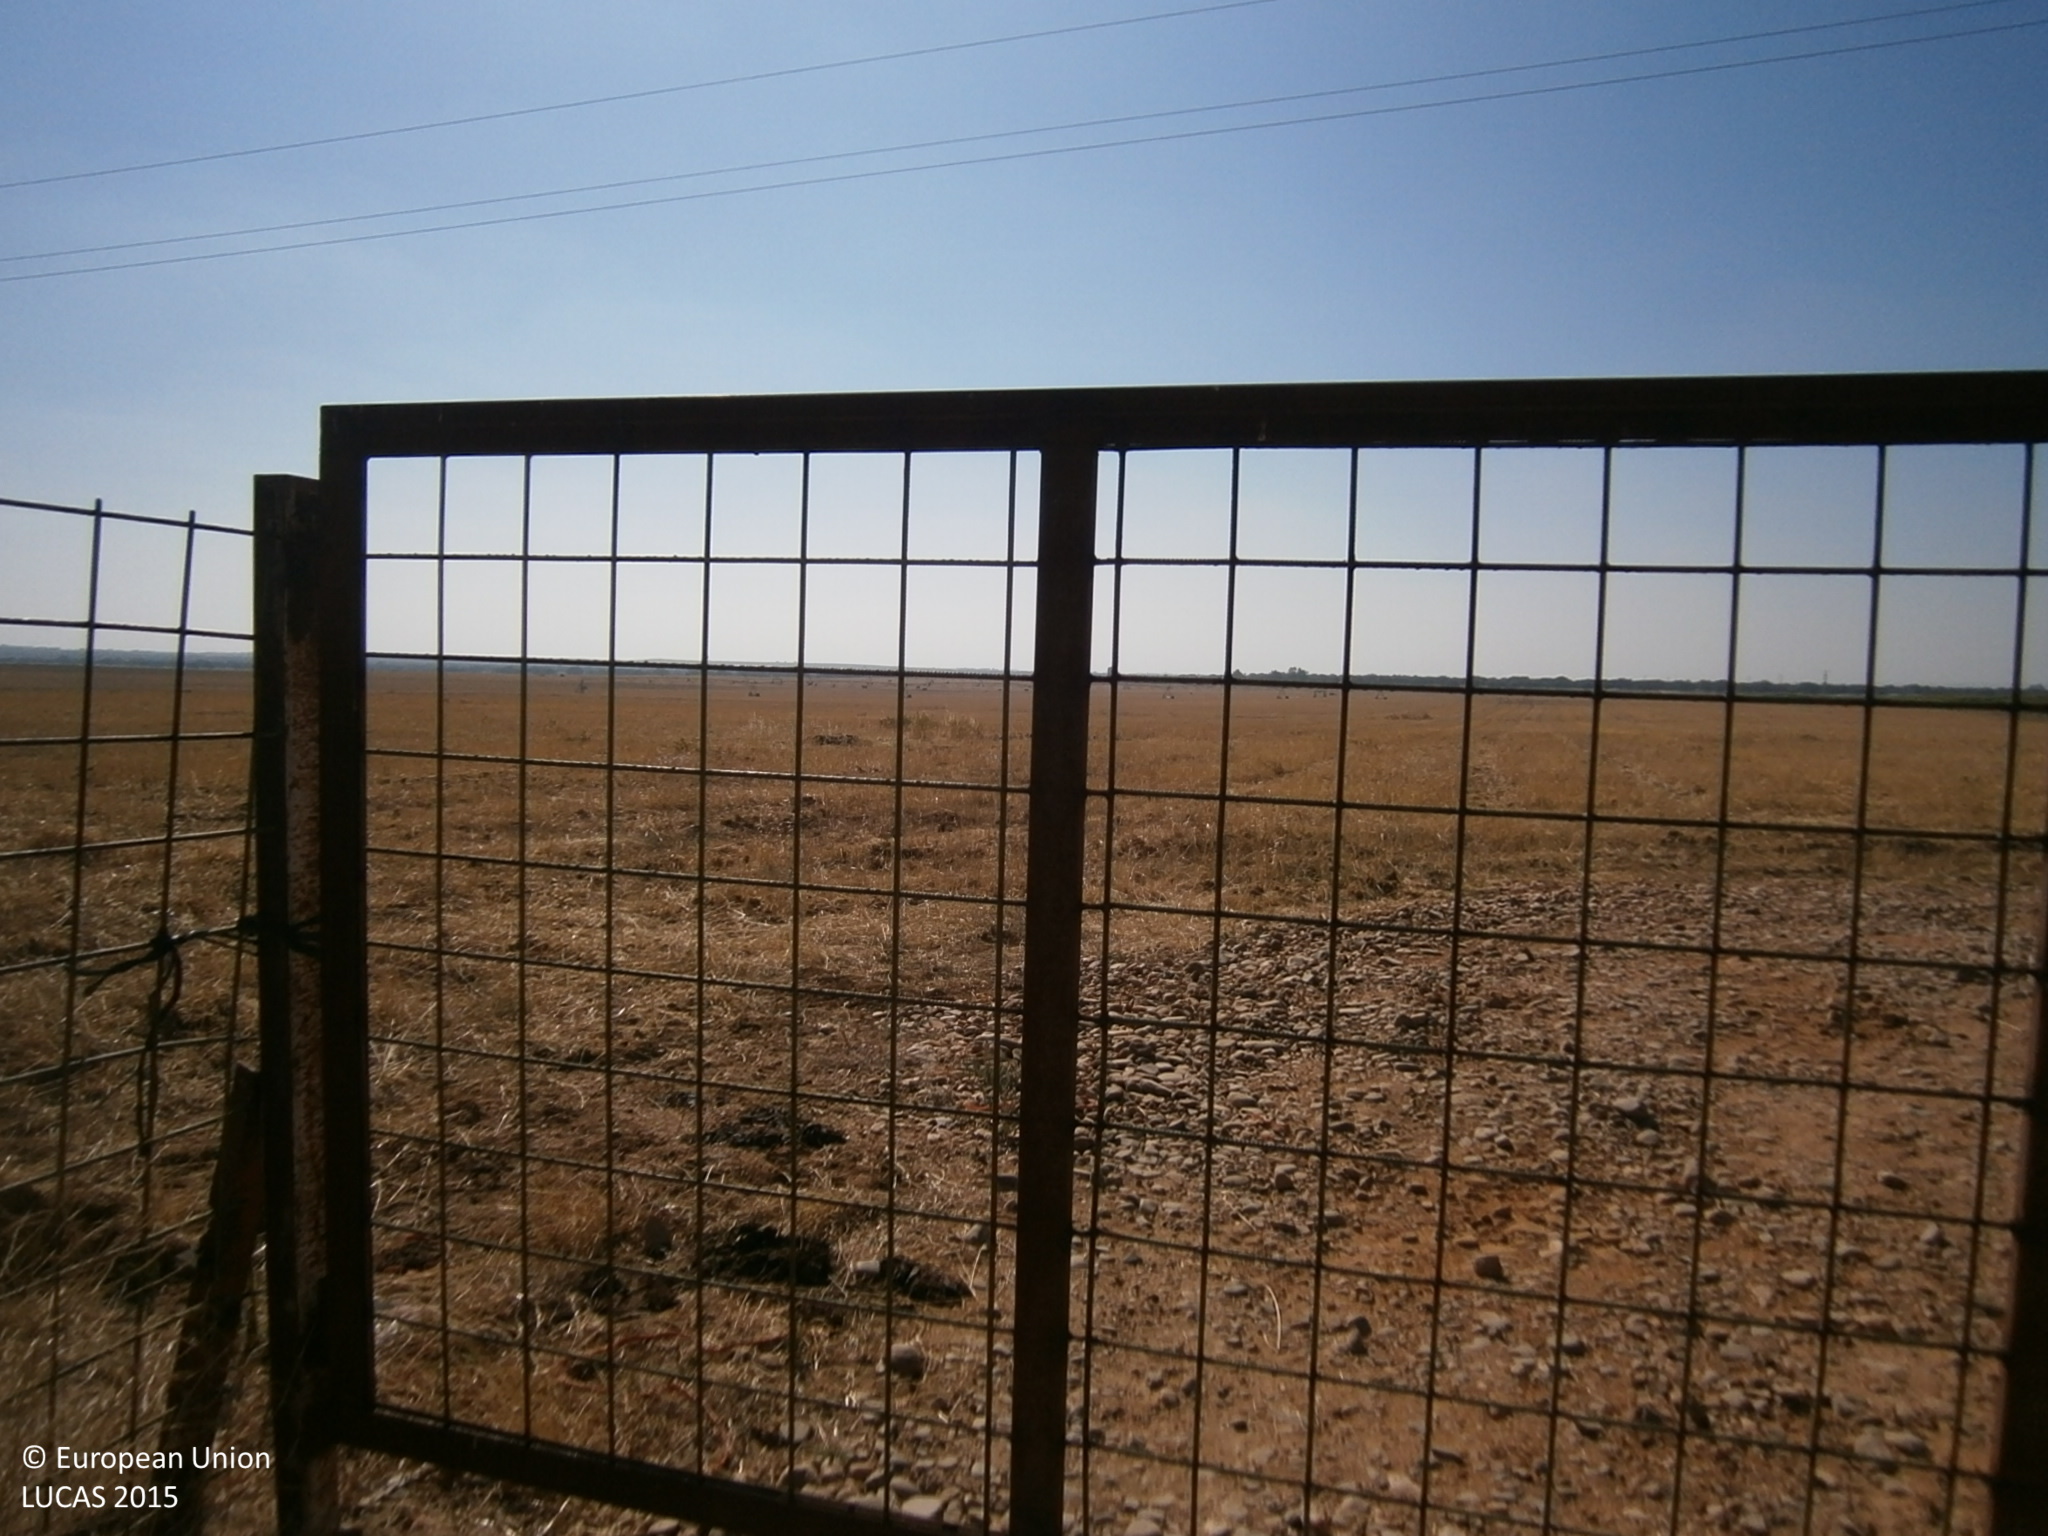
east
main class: Cropland
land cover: Maize
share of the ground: > 75 %
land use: Agriculture (excluding fallow land and kitchen gardens)
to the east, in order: Maize
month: July
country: ES
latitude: 38.9542
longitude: -6.9056
